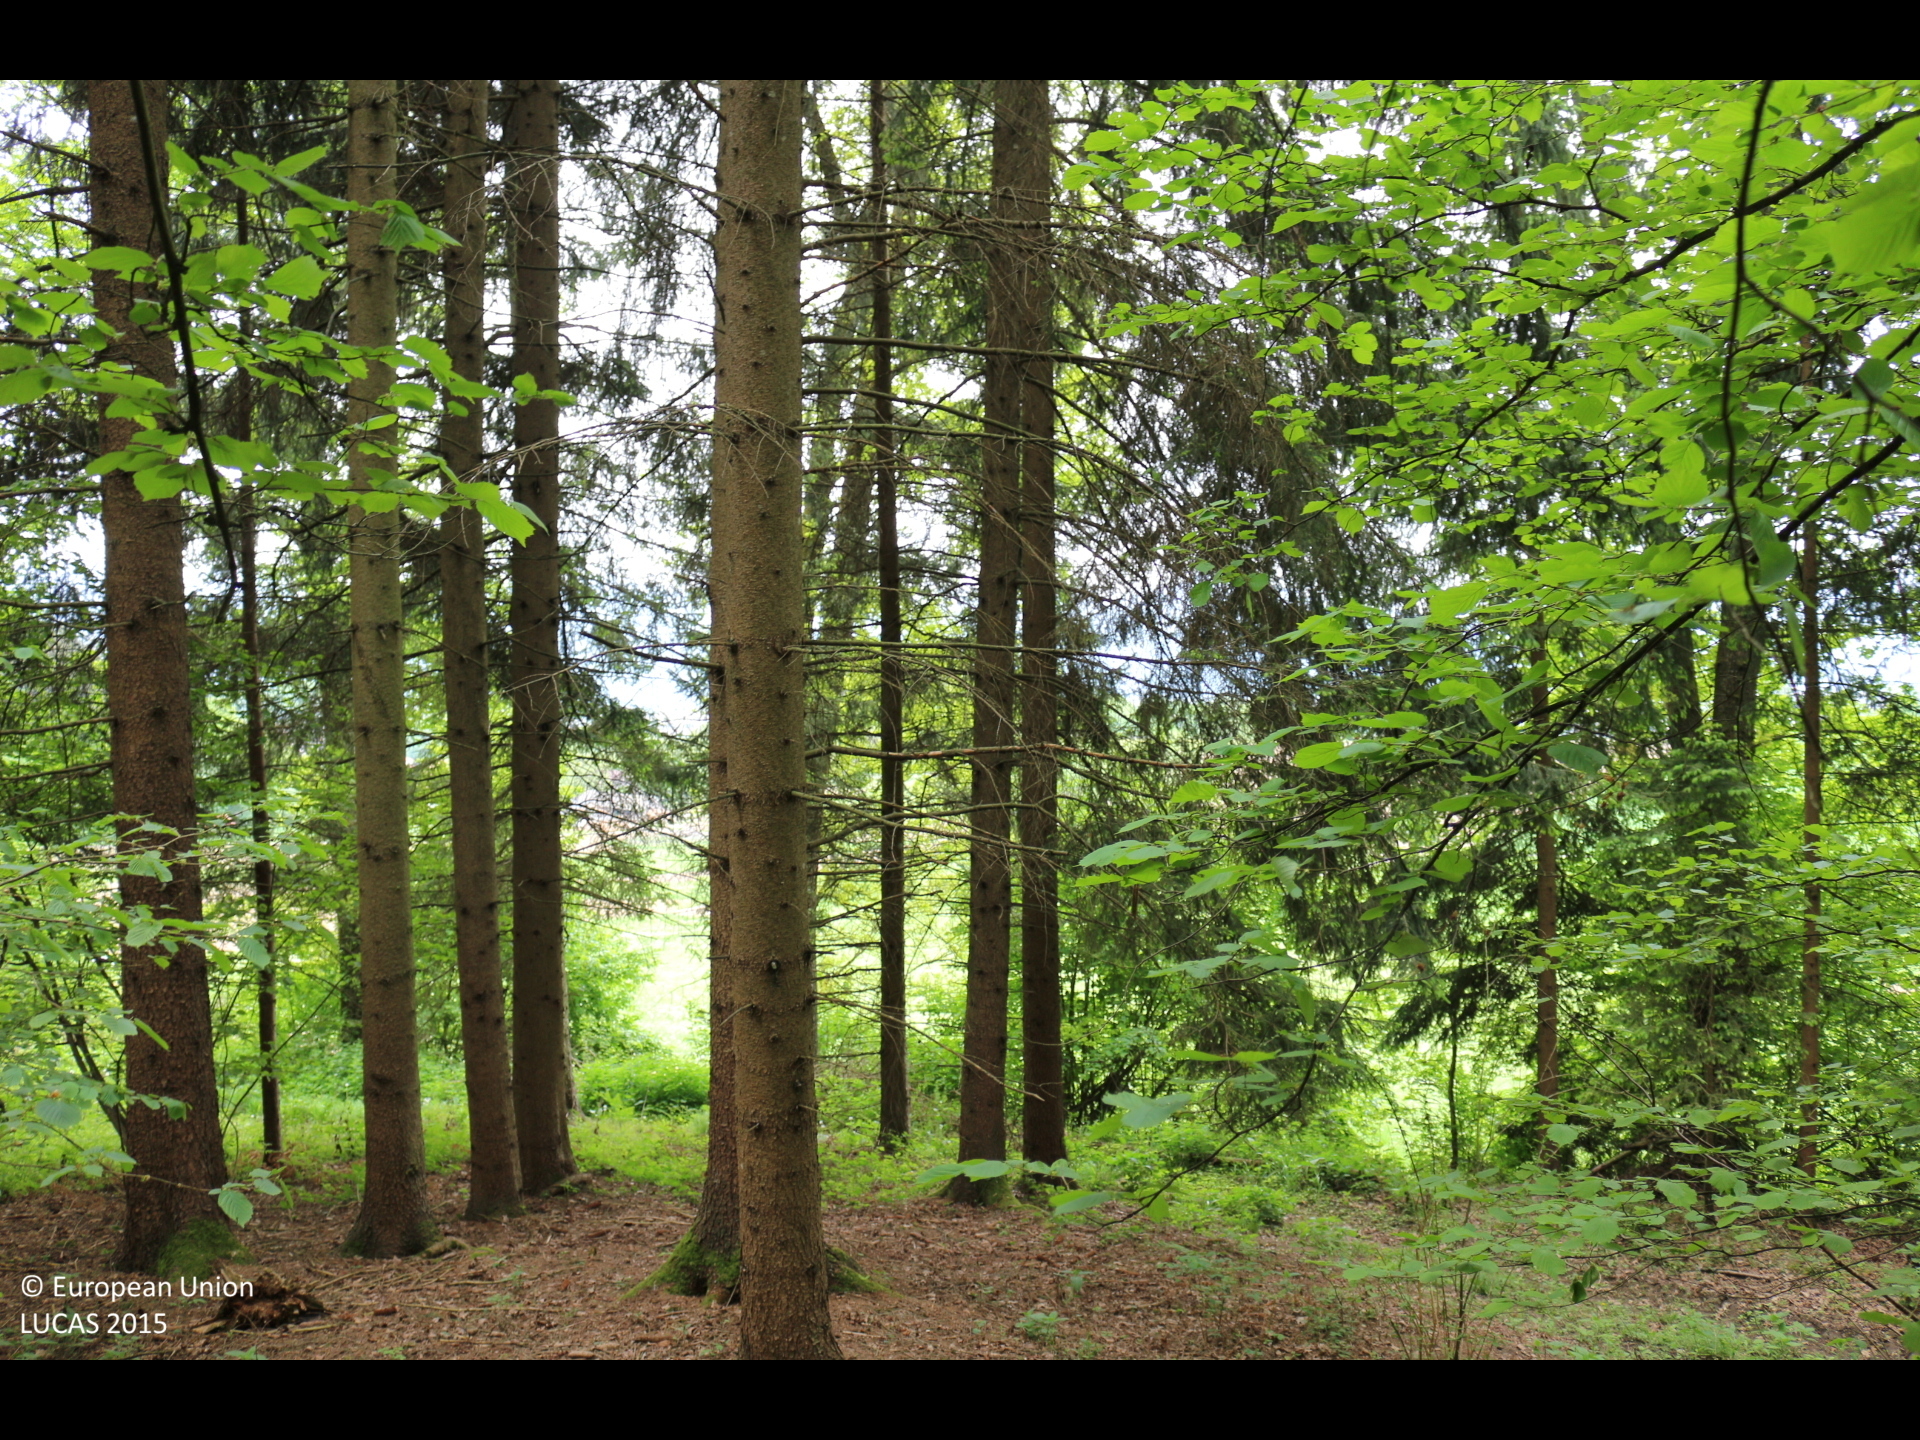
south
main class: Woodland
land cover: Spruce dominated mixed woodland
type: alpine coniferous forest
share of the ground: > 75 %
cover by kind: coniferous forest trees 60 %, broadleaved forest trees 40 %
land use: Forestry
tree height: > 5 m
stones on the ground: < 10 %
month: May
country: AT
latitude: 46.6606
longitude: 14.3233
